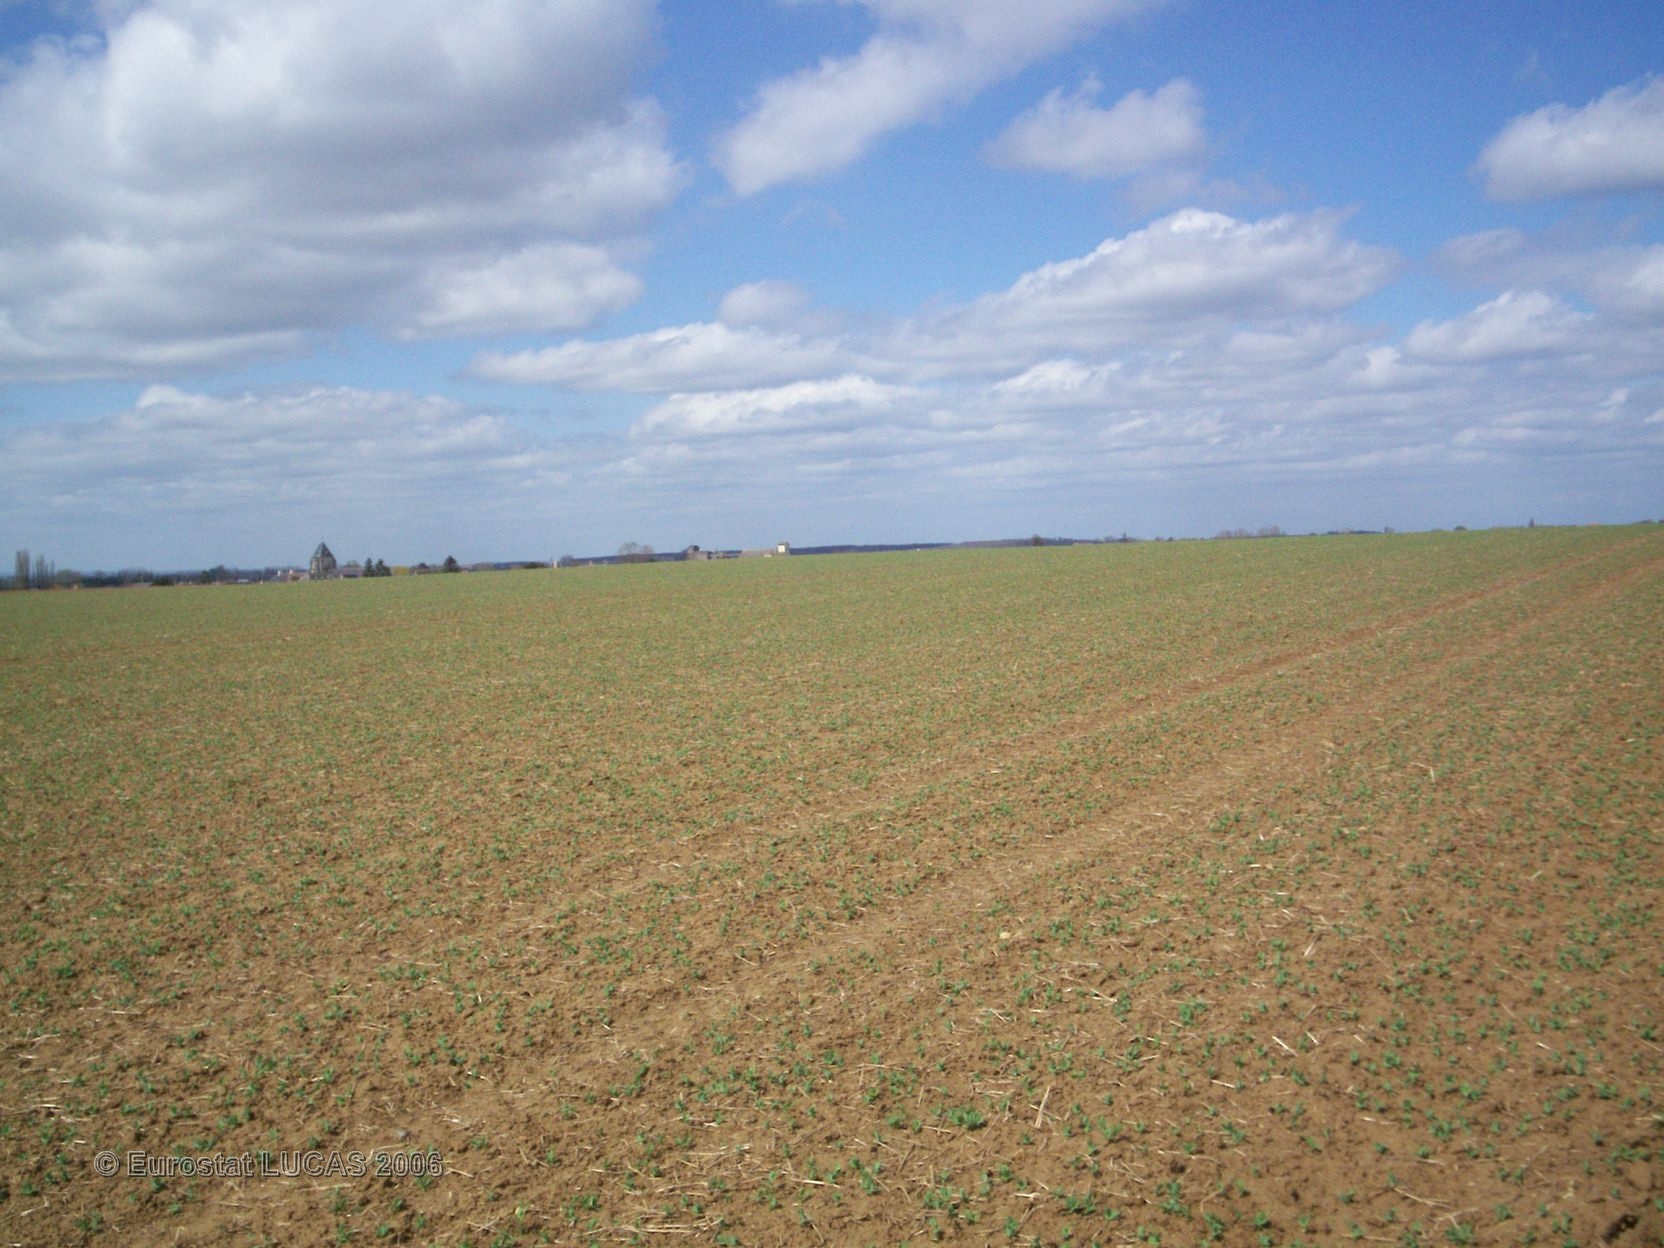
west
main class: Cropland
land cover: Dry pulses
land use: Agriculture (excluding fallow land and kitchen gardens)
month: April
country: FR
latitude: 48.2780
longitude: 0.2309
